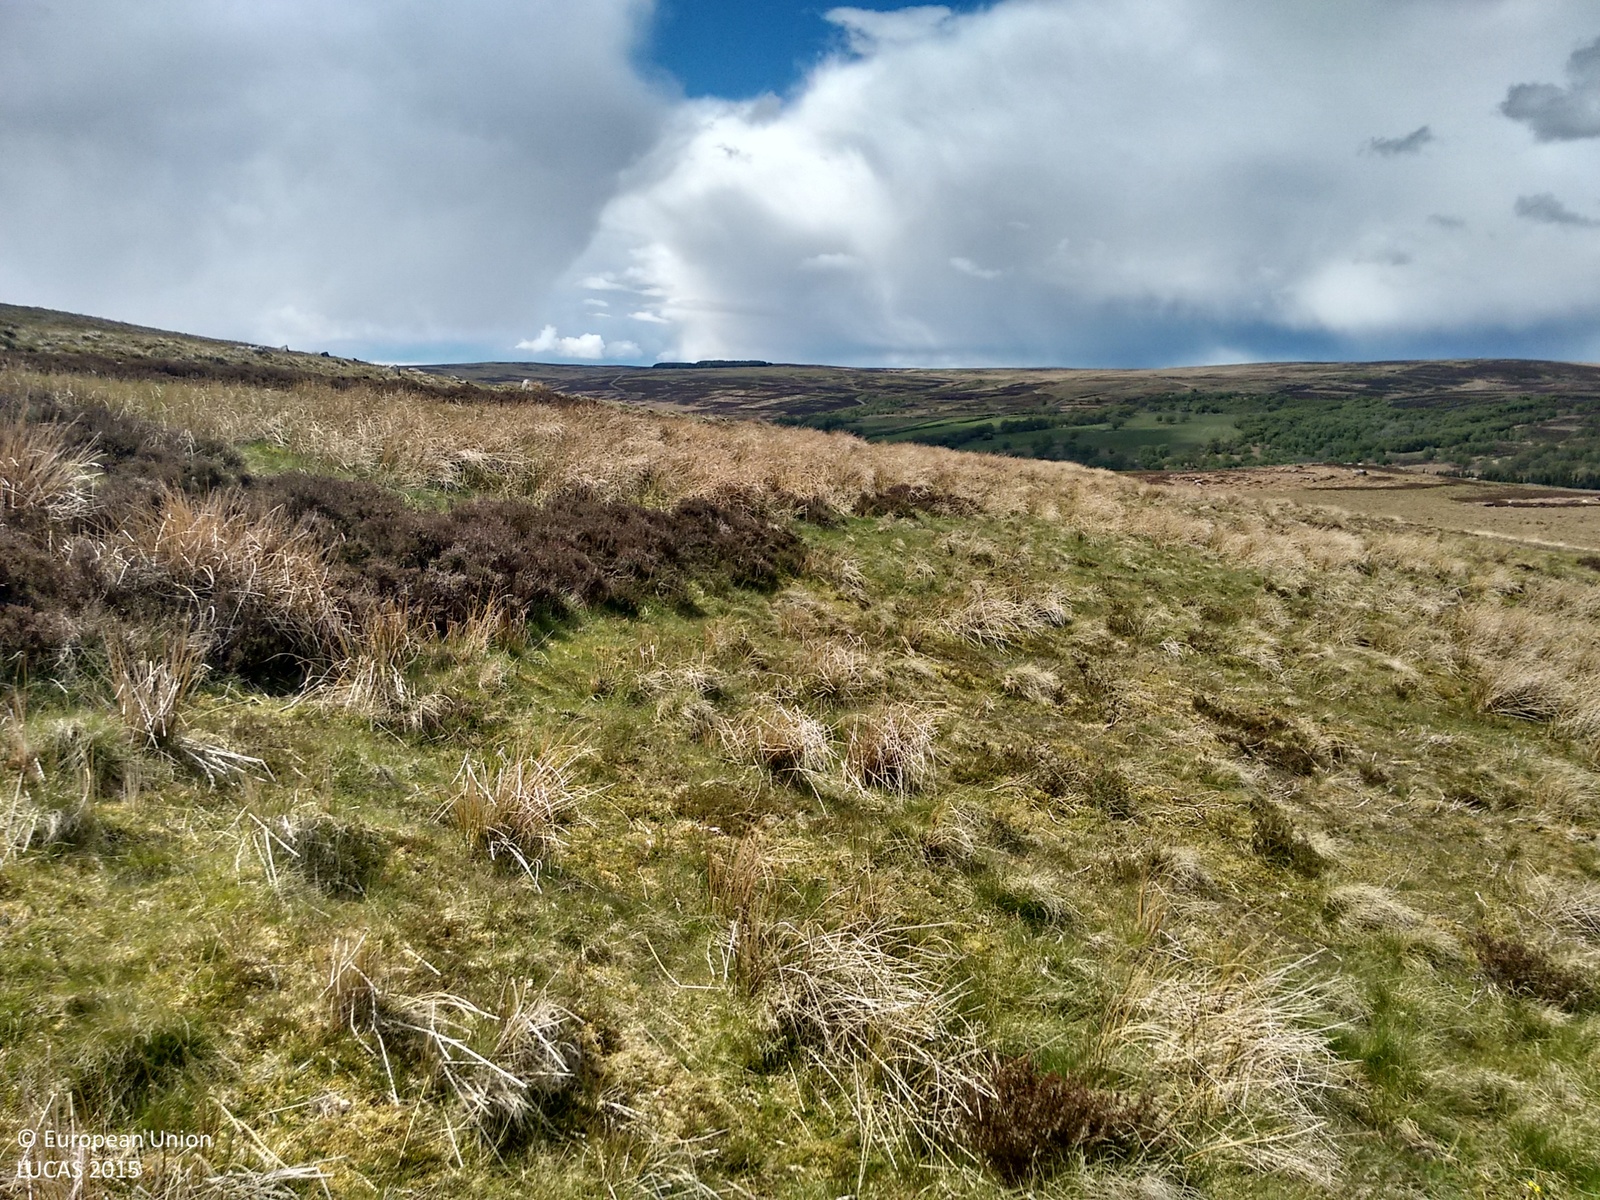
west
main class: Shrubland
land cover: Shrubland without tree cover
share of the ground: > 75 %
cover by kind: shrubs 80 %, herbaceous plants 20 %
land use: Agriculture (excluding fallow land and kitchen gardens)
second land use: Community services
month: May
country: GB
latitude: 55.3027
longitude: -2.1055
